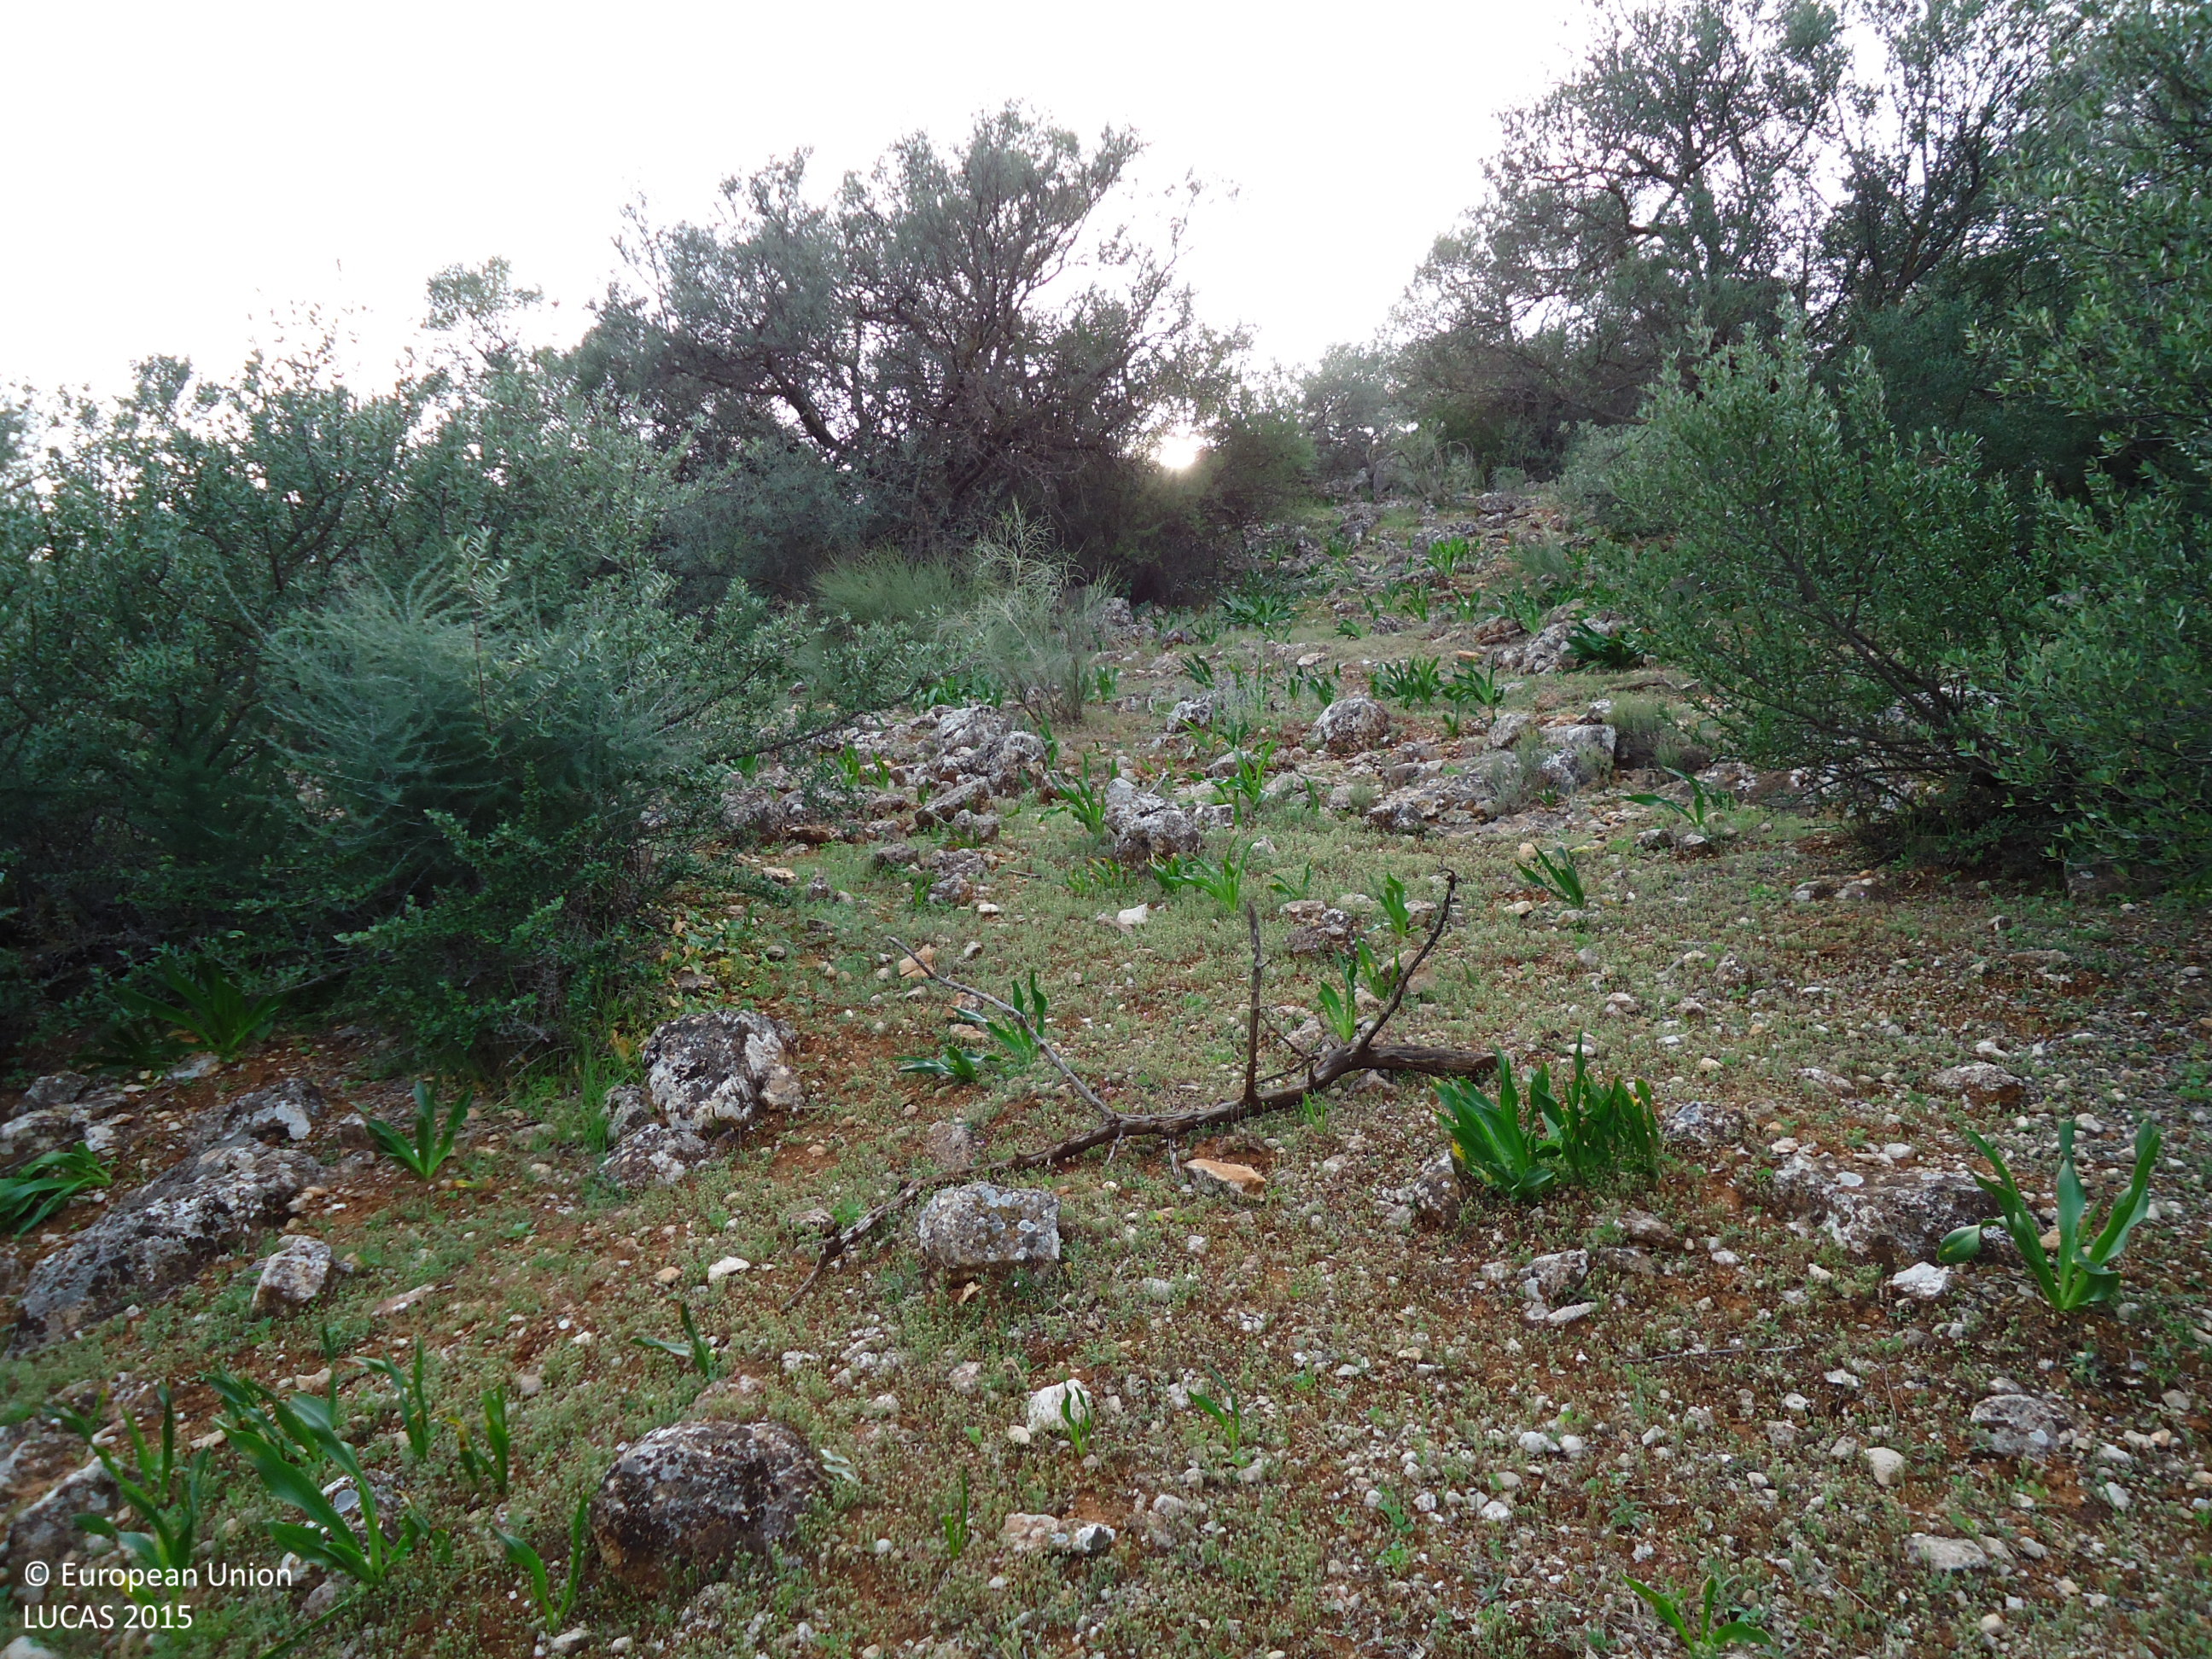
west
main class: Shrubland
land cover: Shrubland with sparse tree cover
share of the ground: 25 - 50 %
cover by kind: herbaceous plants 60 %, shrubs 35 %, broadleaved forest trees 5 %
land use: Semi-natural and natural areas not in use
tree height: < 5 m
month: April
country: ES
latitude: 37.1659
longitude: -4.8341
